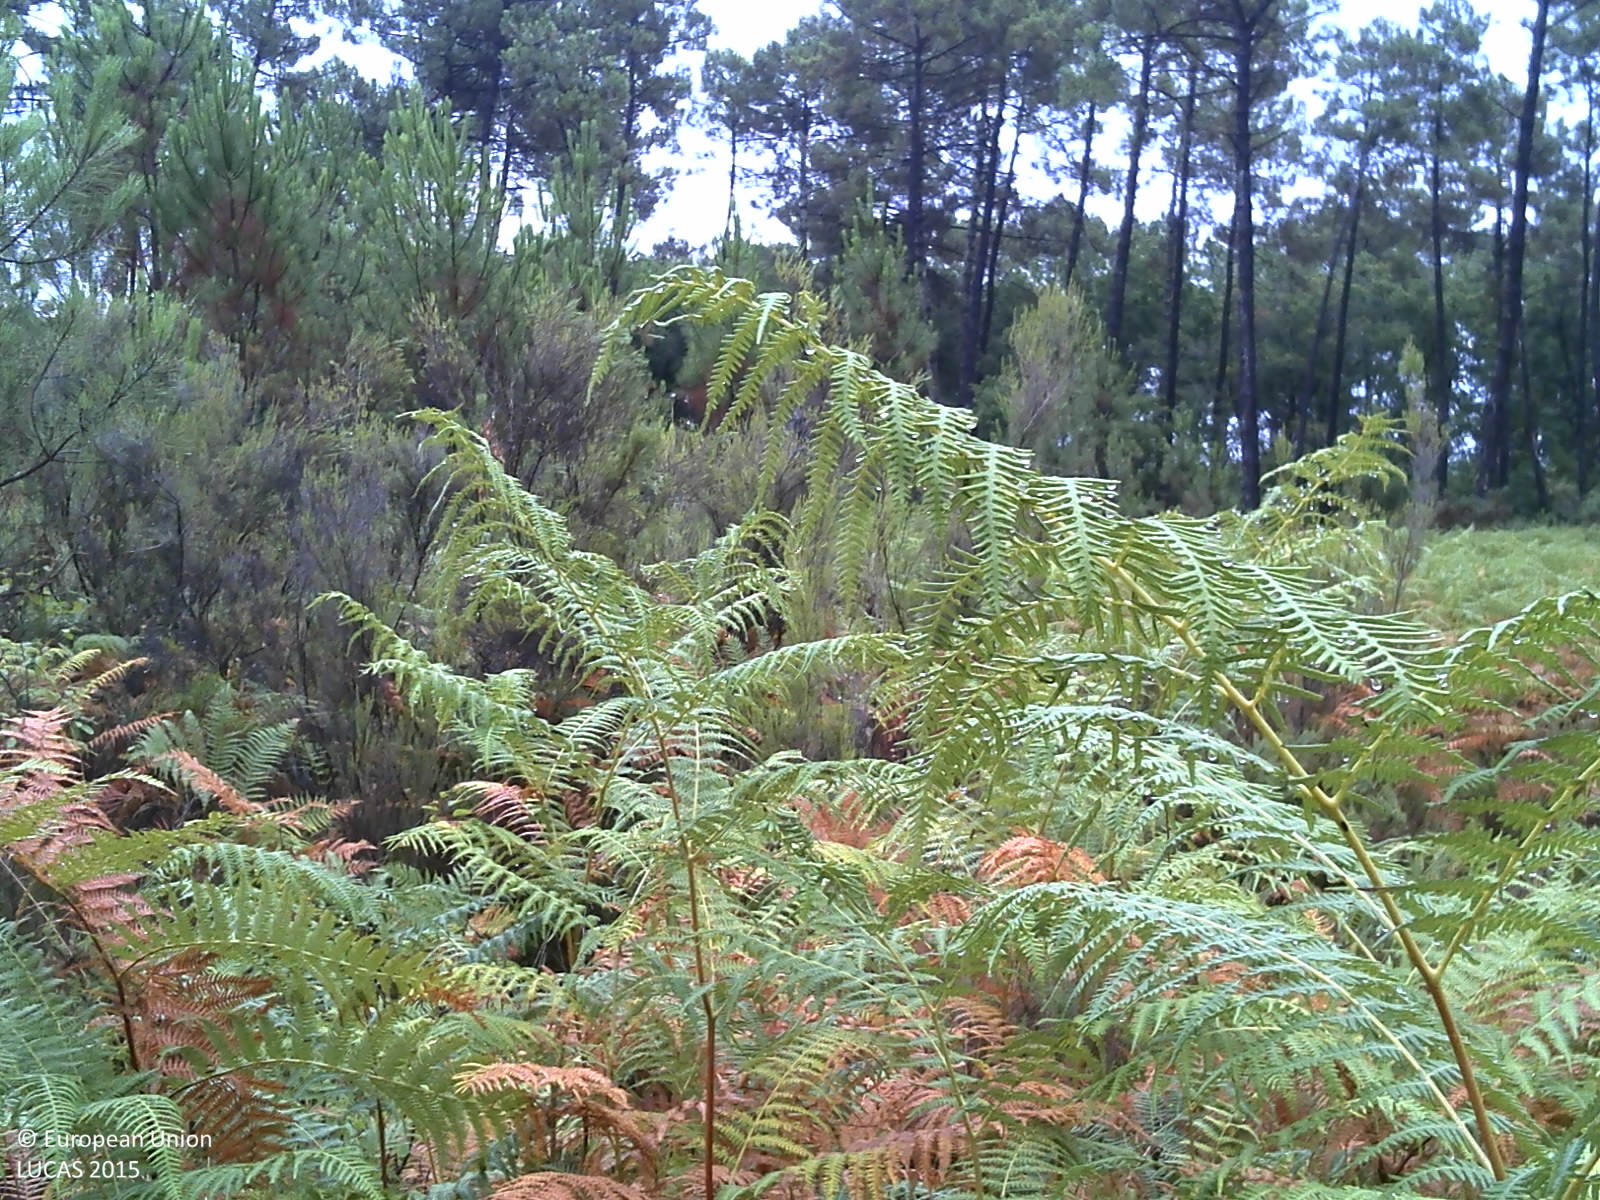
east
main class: Woodland
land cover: Pine dominated coniferous woodland
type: coniferous forest of the mediterranean region
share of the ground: > 75 %
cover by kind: coniferous forest trees 60 %, shrubs 30 %, herbaceous plants 5 %, lichens and mosses 5 %
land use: Forestry
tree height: < 5 m
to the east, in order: Pine dominated coniferous woodland; Tracks; Pine dominated coniferous woodland; Pine dominated mixed woodland; Tracks; Pine dominated mixed woodland; Paved roads, cycling and walking lanes; Grass margins; Ditches and canals; Pine dominated mixed woodland
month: August
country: FR
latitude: 44.6011
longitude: -0.9947
